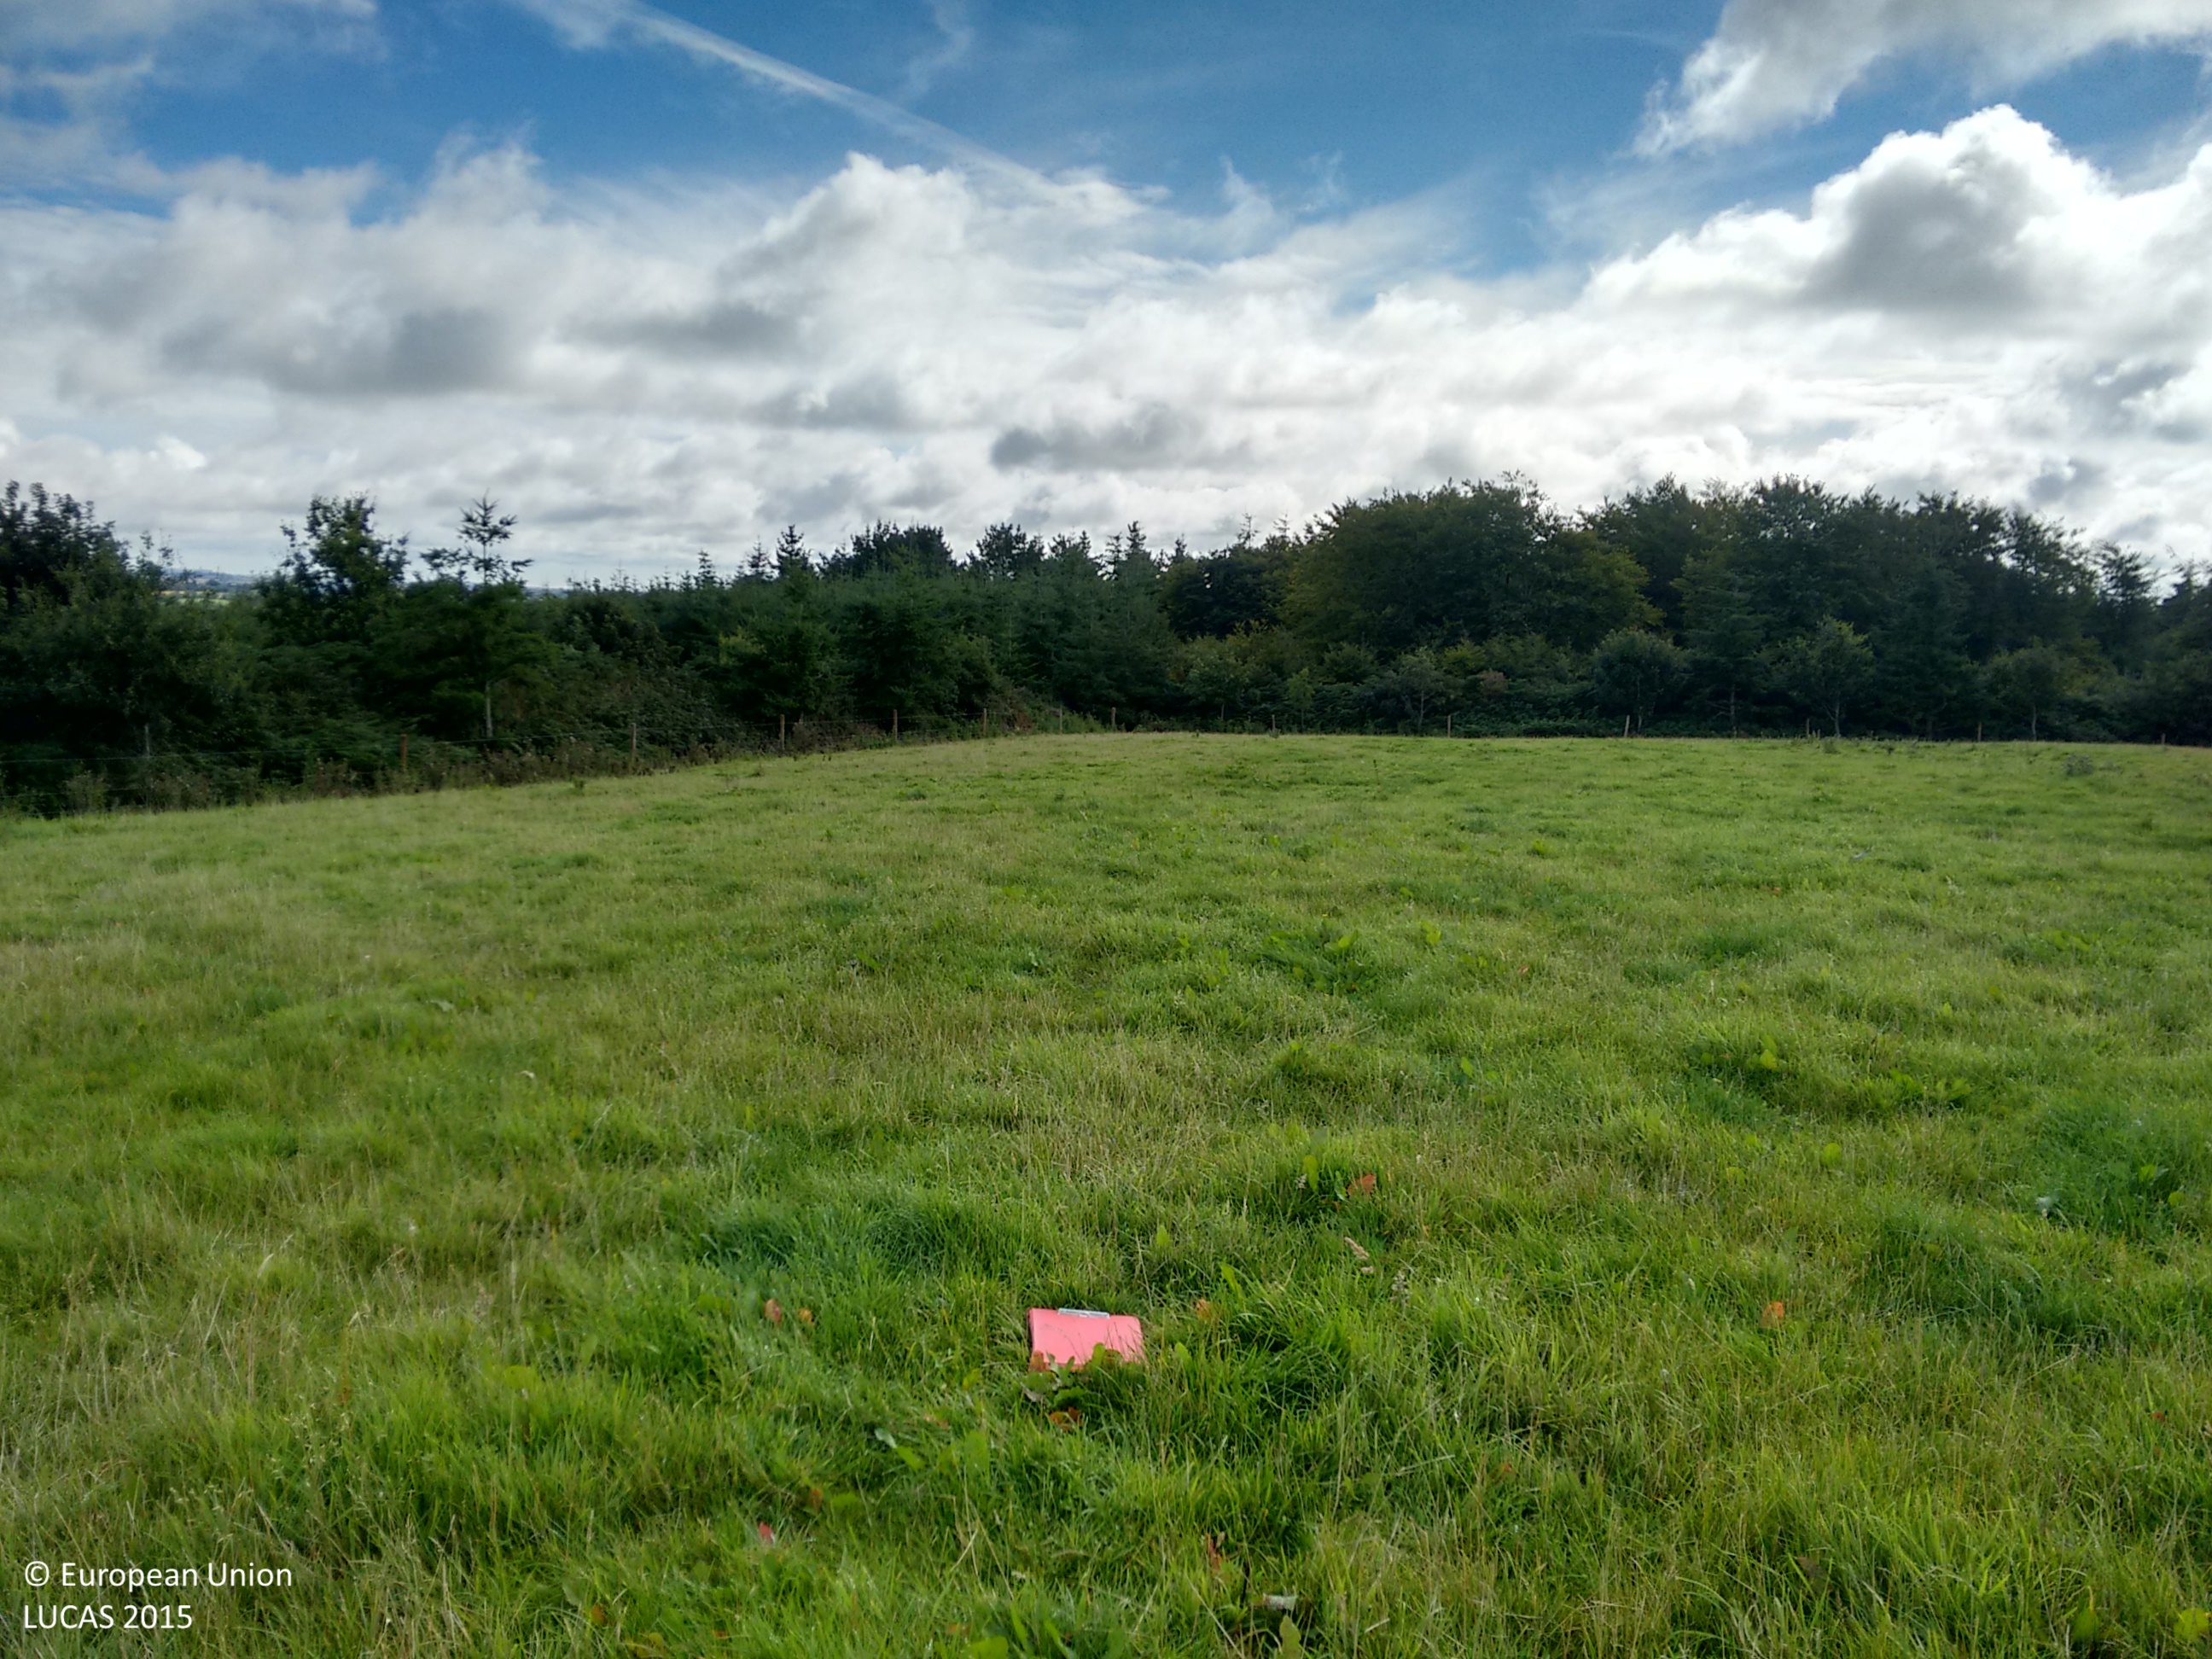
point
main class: Grassland
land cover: Grassland without tree/shrub cover
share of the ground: > 75 %
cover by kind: herbaceous plants 100 %
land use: Agriculture (excluding fallow land and kitchen gardens)
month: August
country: IE
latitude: 52.4216
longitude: -6.6454
